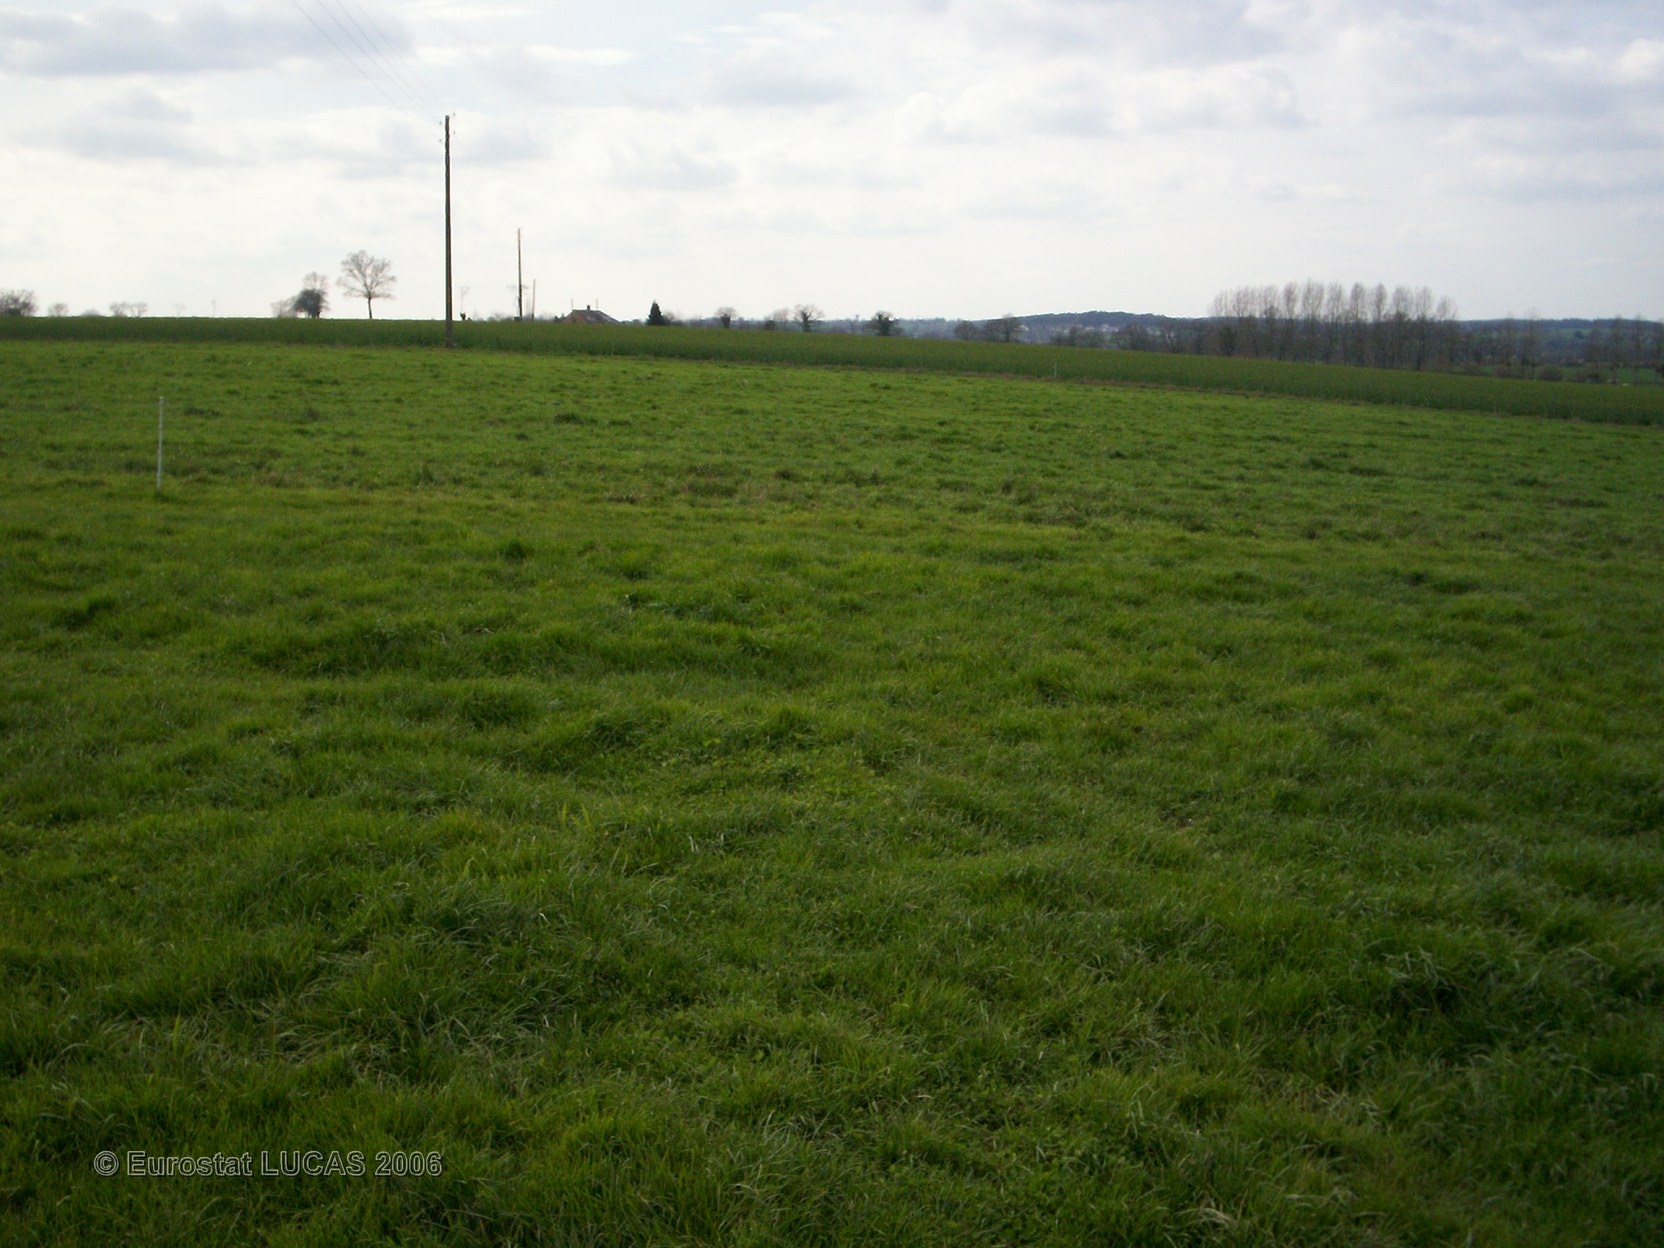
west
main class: Grassland
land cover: Grassland without tree/shrub cover
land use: Agriculture (excluding fallow land and kitchen gardens)
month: April
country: FR
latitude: 47.9390
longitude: -1.5719
